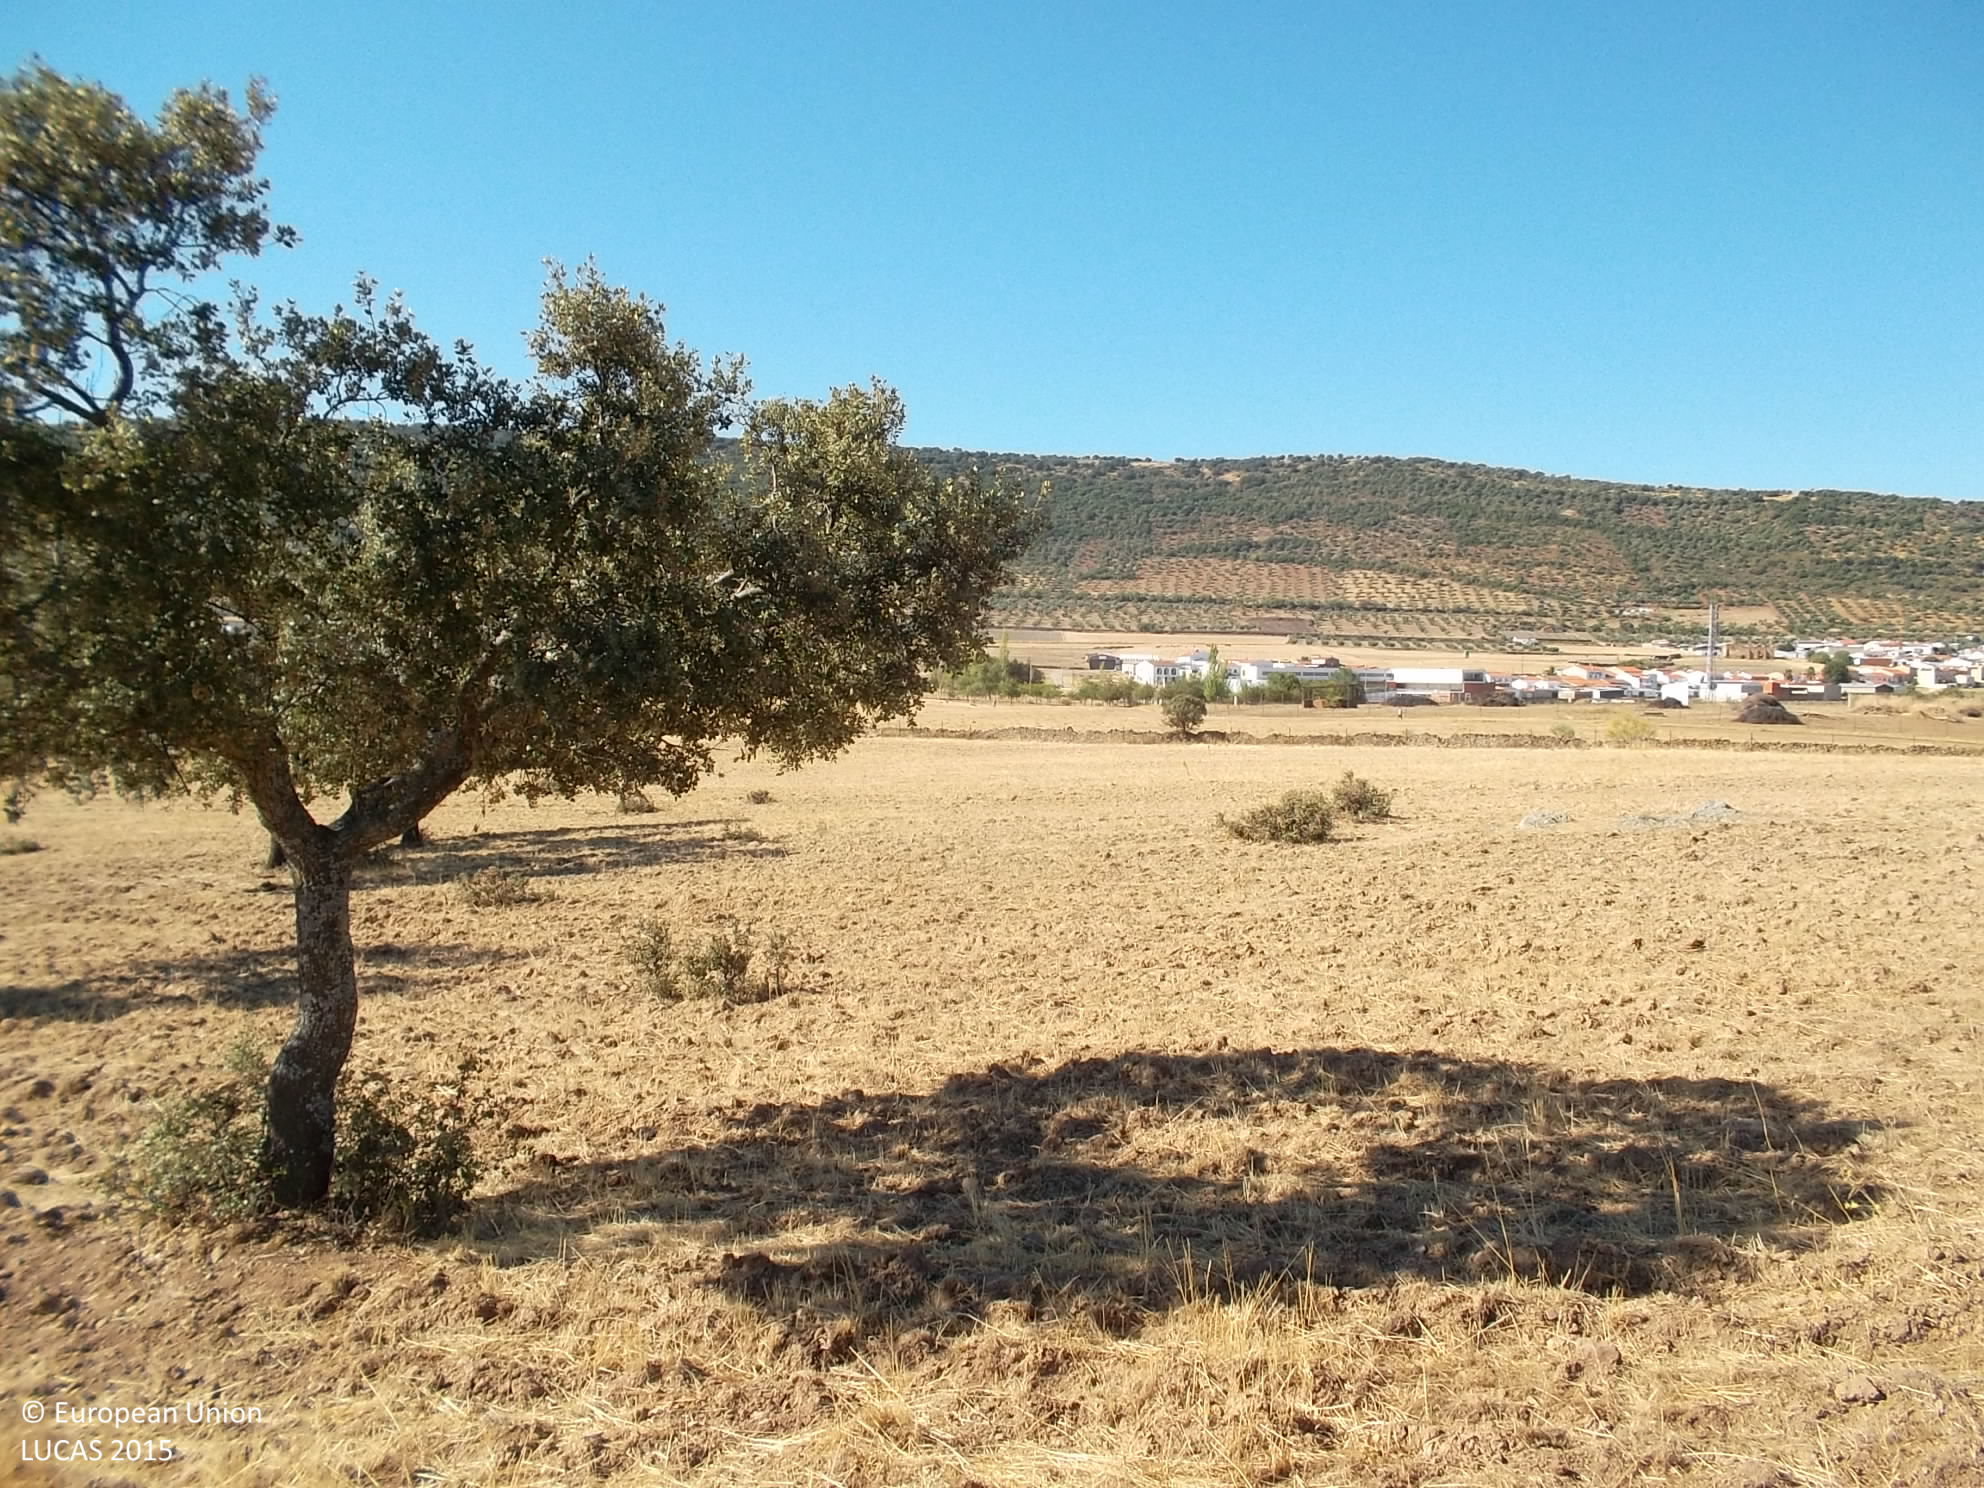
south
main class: Woodland
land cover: Broadleaved woodland
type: broadleaved evergreen forest
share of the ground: 10 - 25 %
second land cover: Grassland without tree/shrub cover
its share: > 75 %
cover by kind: herbaceous plants 85 %, broadleaved forest trees 10 %, shrubs 5 %
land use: Forestry
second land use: Agriculture (excluding fallow land and kitchen gardens)
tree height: < 5 m
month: August
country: ES
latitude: 38.5272
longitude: -6.6082
